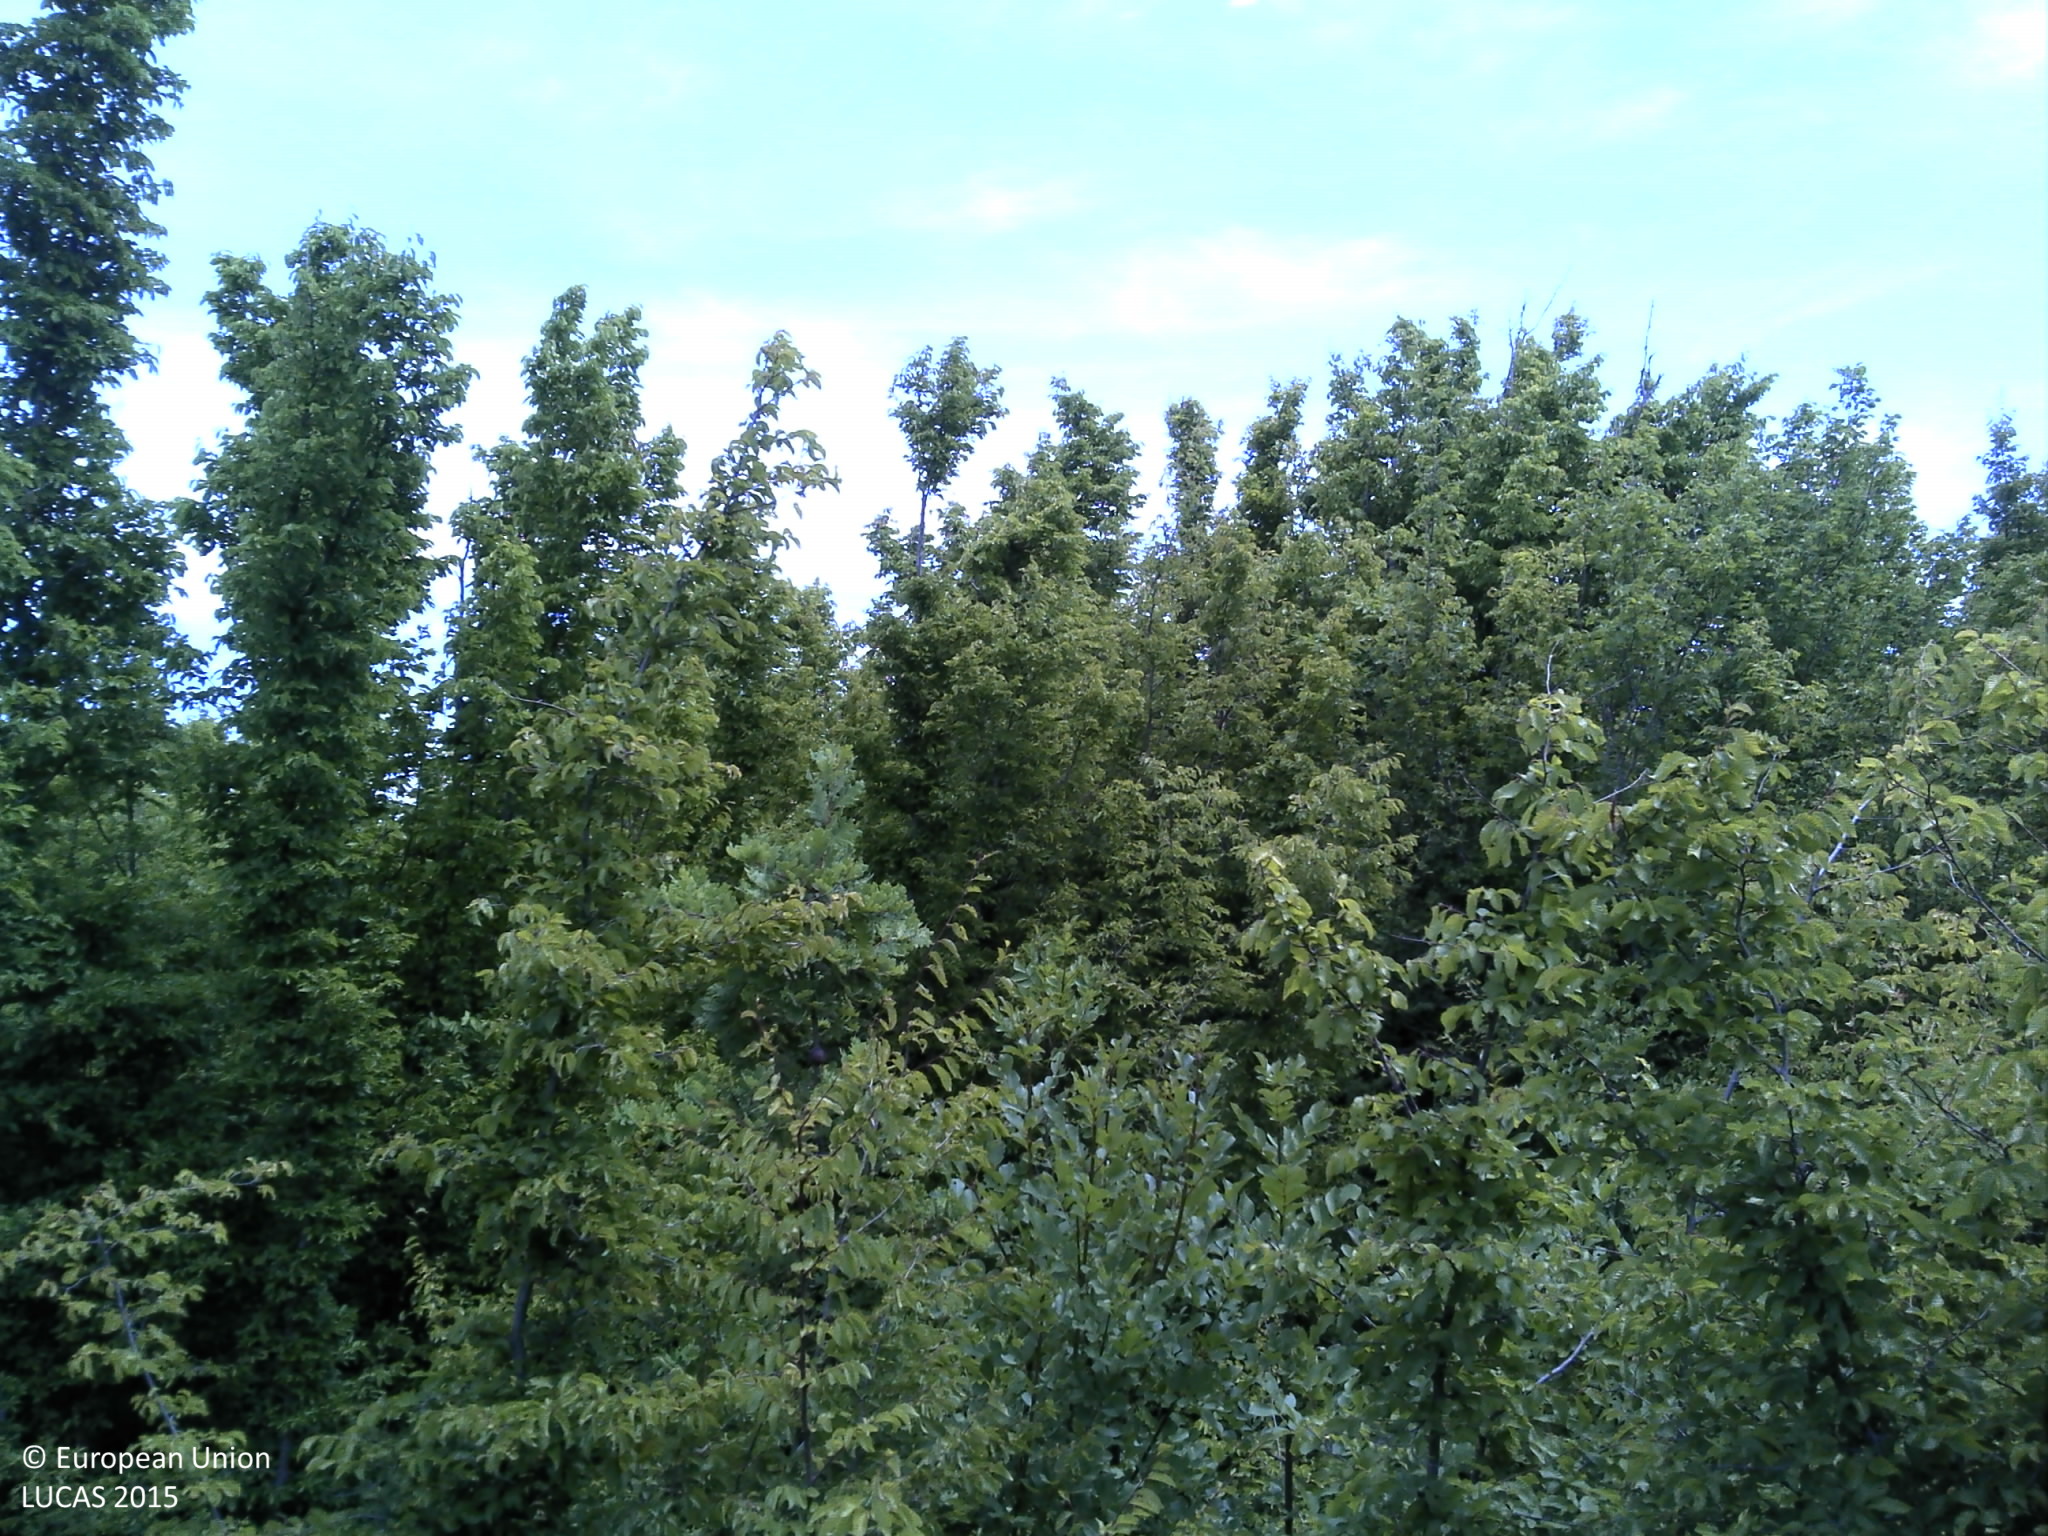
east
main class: Woodland
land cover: Broadleaved woodland
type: thermophilous deciduous forest
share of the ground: 25 - 50 %
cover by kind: shrubs 40 %, broadleaved forest trees 35 %, unconsolidated bare surface 15 %, coniferous forest trees 10 %
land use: Semi-natural and natural areas not in use
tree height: > 5 m
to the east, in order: Broadleaved woodland; Tracks; Broadleaved woodland
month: June
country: HR
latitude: 44.0671
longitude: 16.0226
